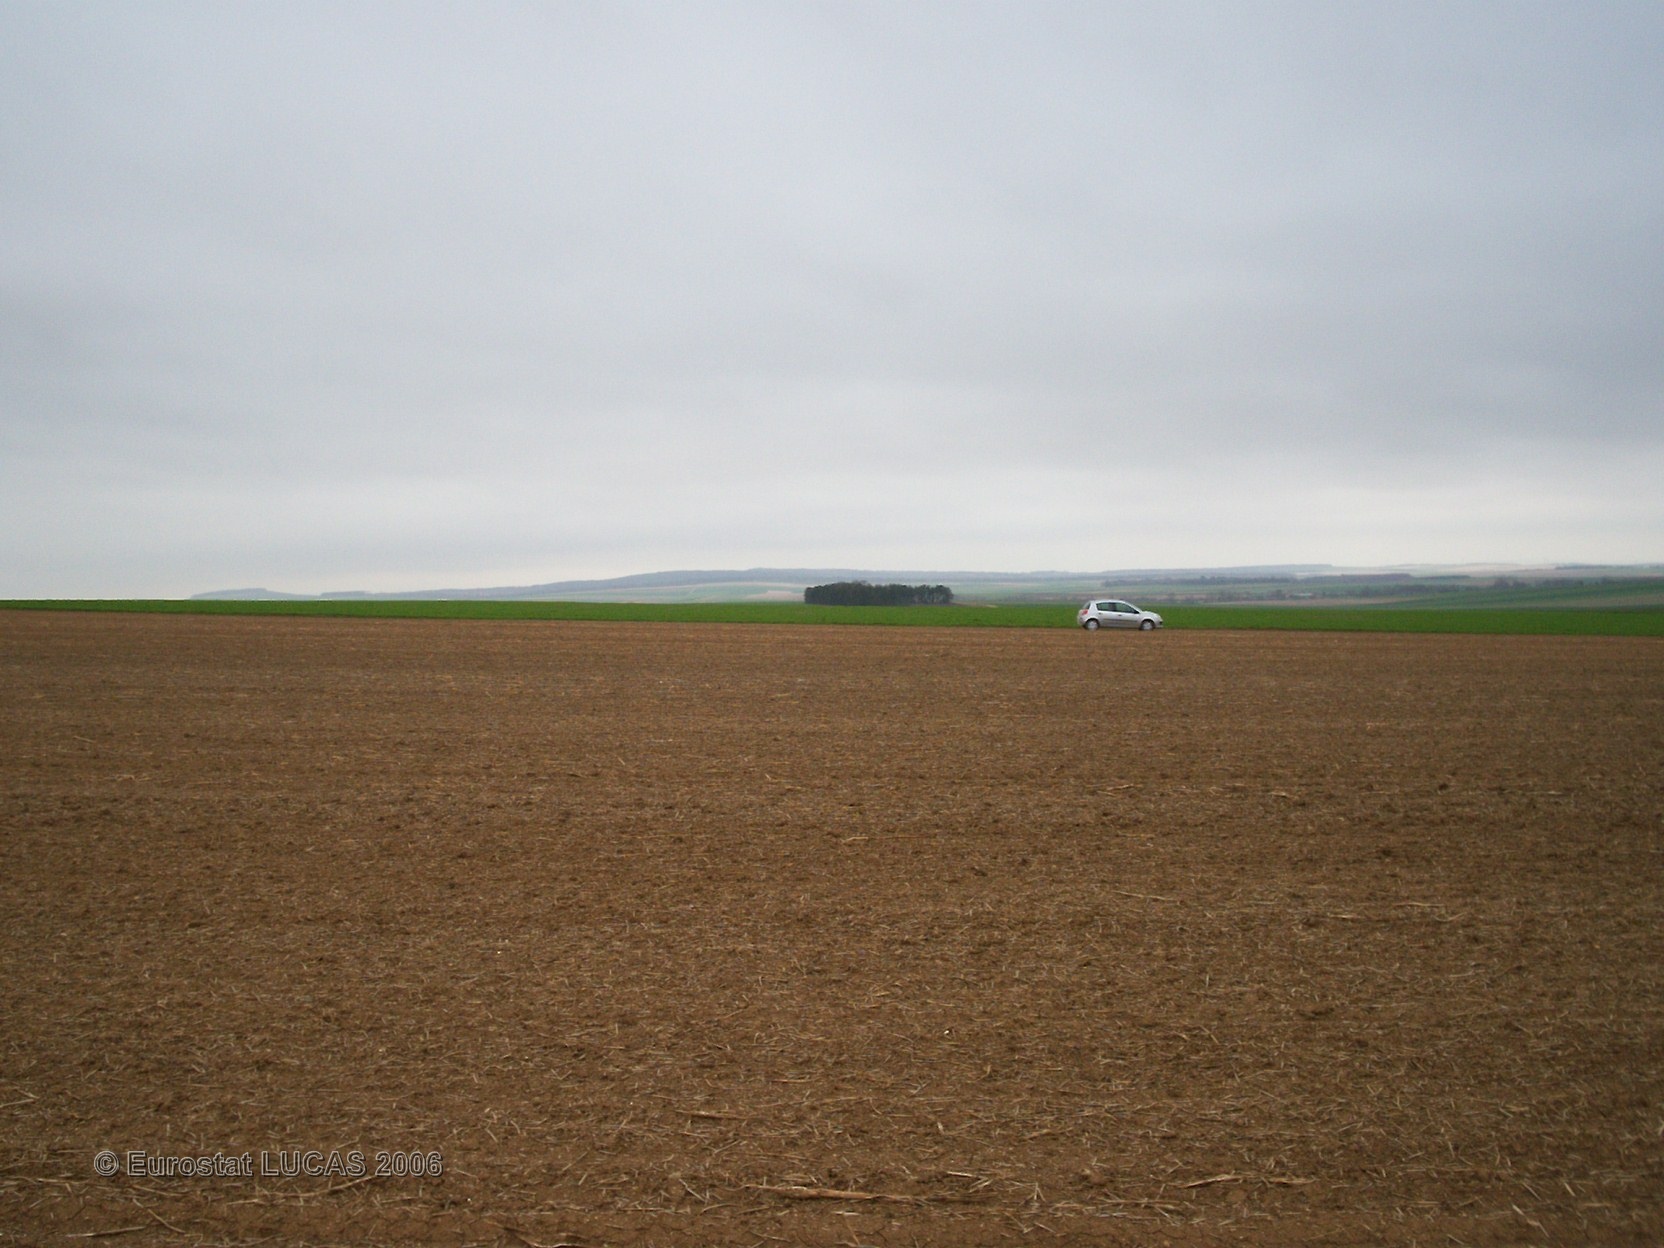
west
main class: Cropland
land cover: Sugar beet
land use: Agriculture (excluding fallow land and kitchen gardens)
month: April
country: FR
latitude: 49.2729
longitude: 4.4298
